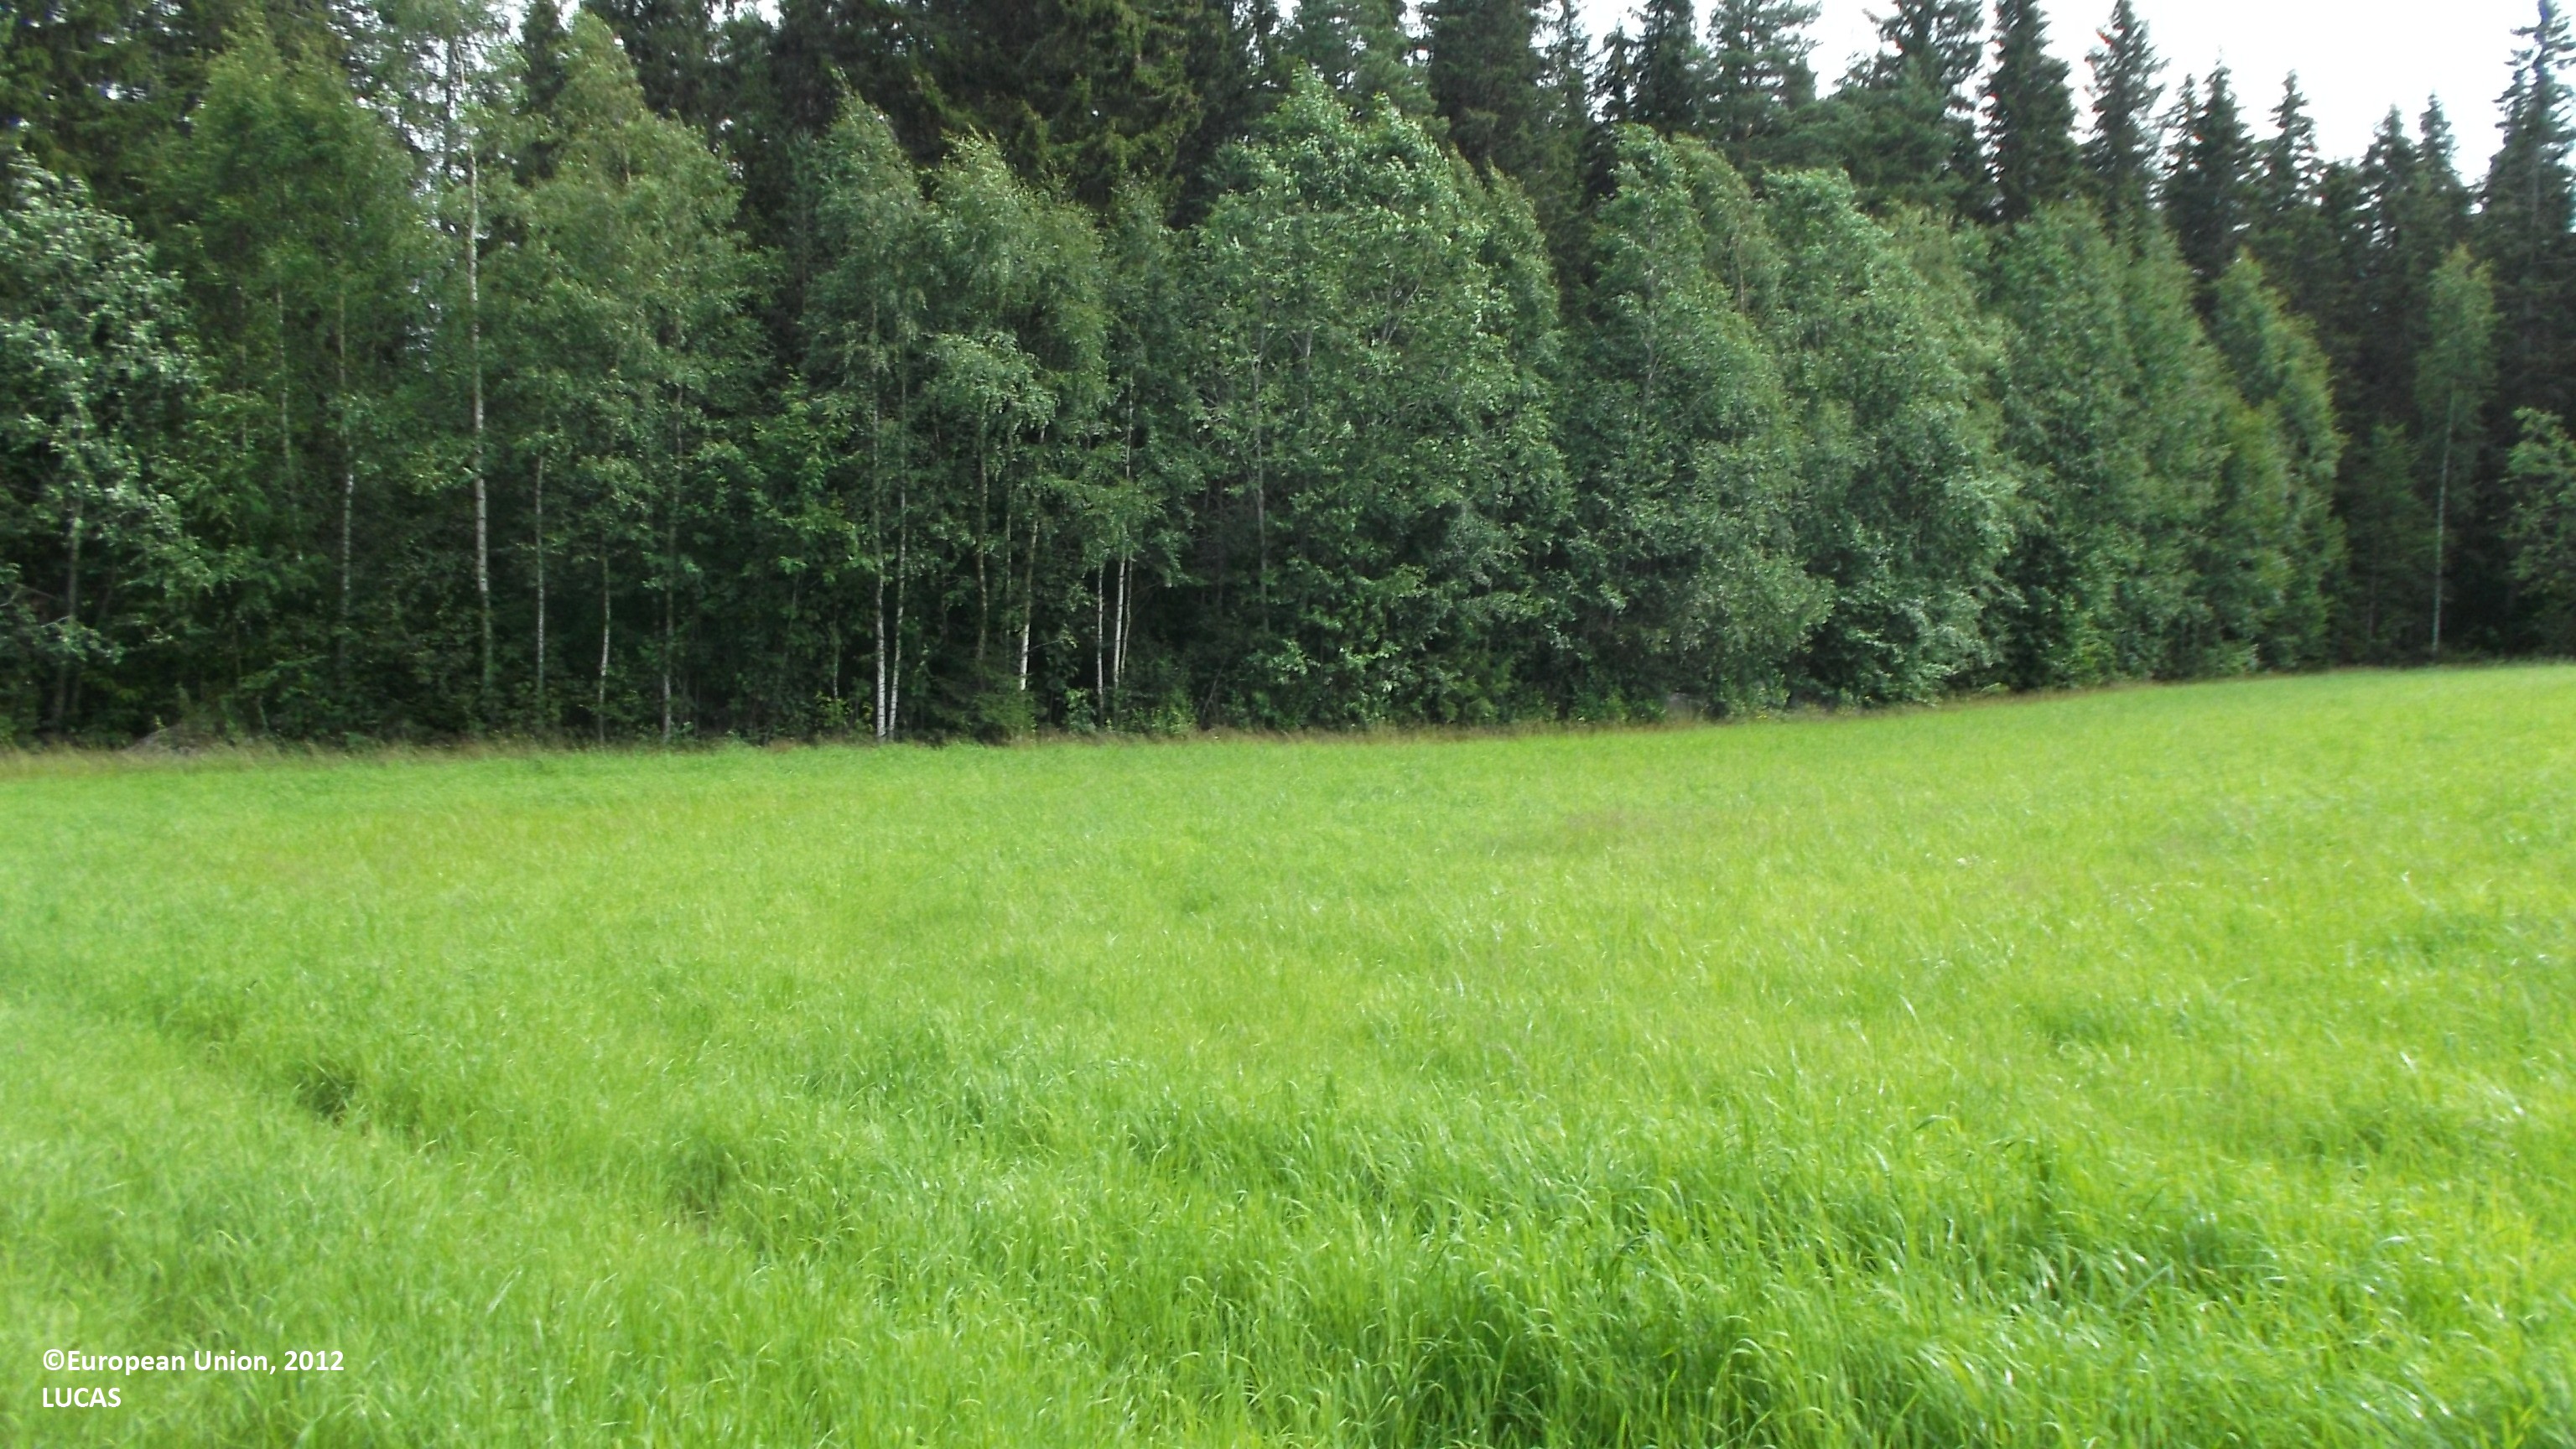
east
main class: Cropland
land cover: Temporary grasslands
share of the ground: > 75 %
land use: Agriculture (excluding fallow land and kitchen gardens)
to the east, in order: Temporary grasslands; Ditches and canals; Other mixed woodland; Spruce dominated mixed woodland; Broadleaved woodland; Inland marshes; Other mixed woodland
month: July
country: FI
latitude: 63.5428
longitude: 23.0712
